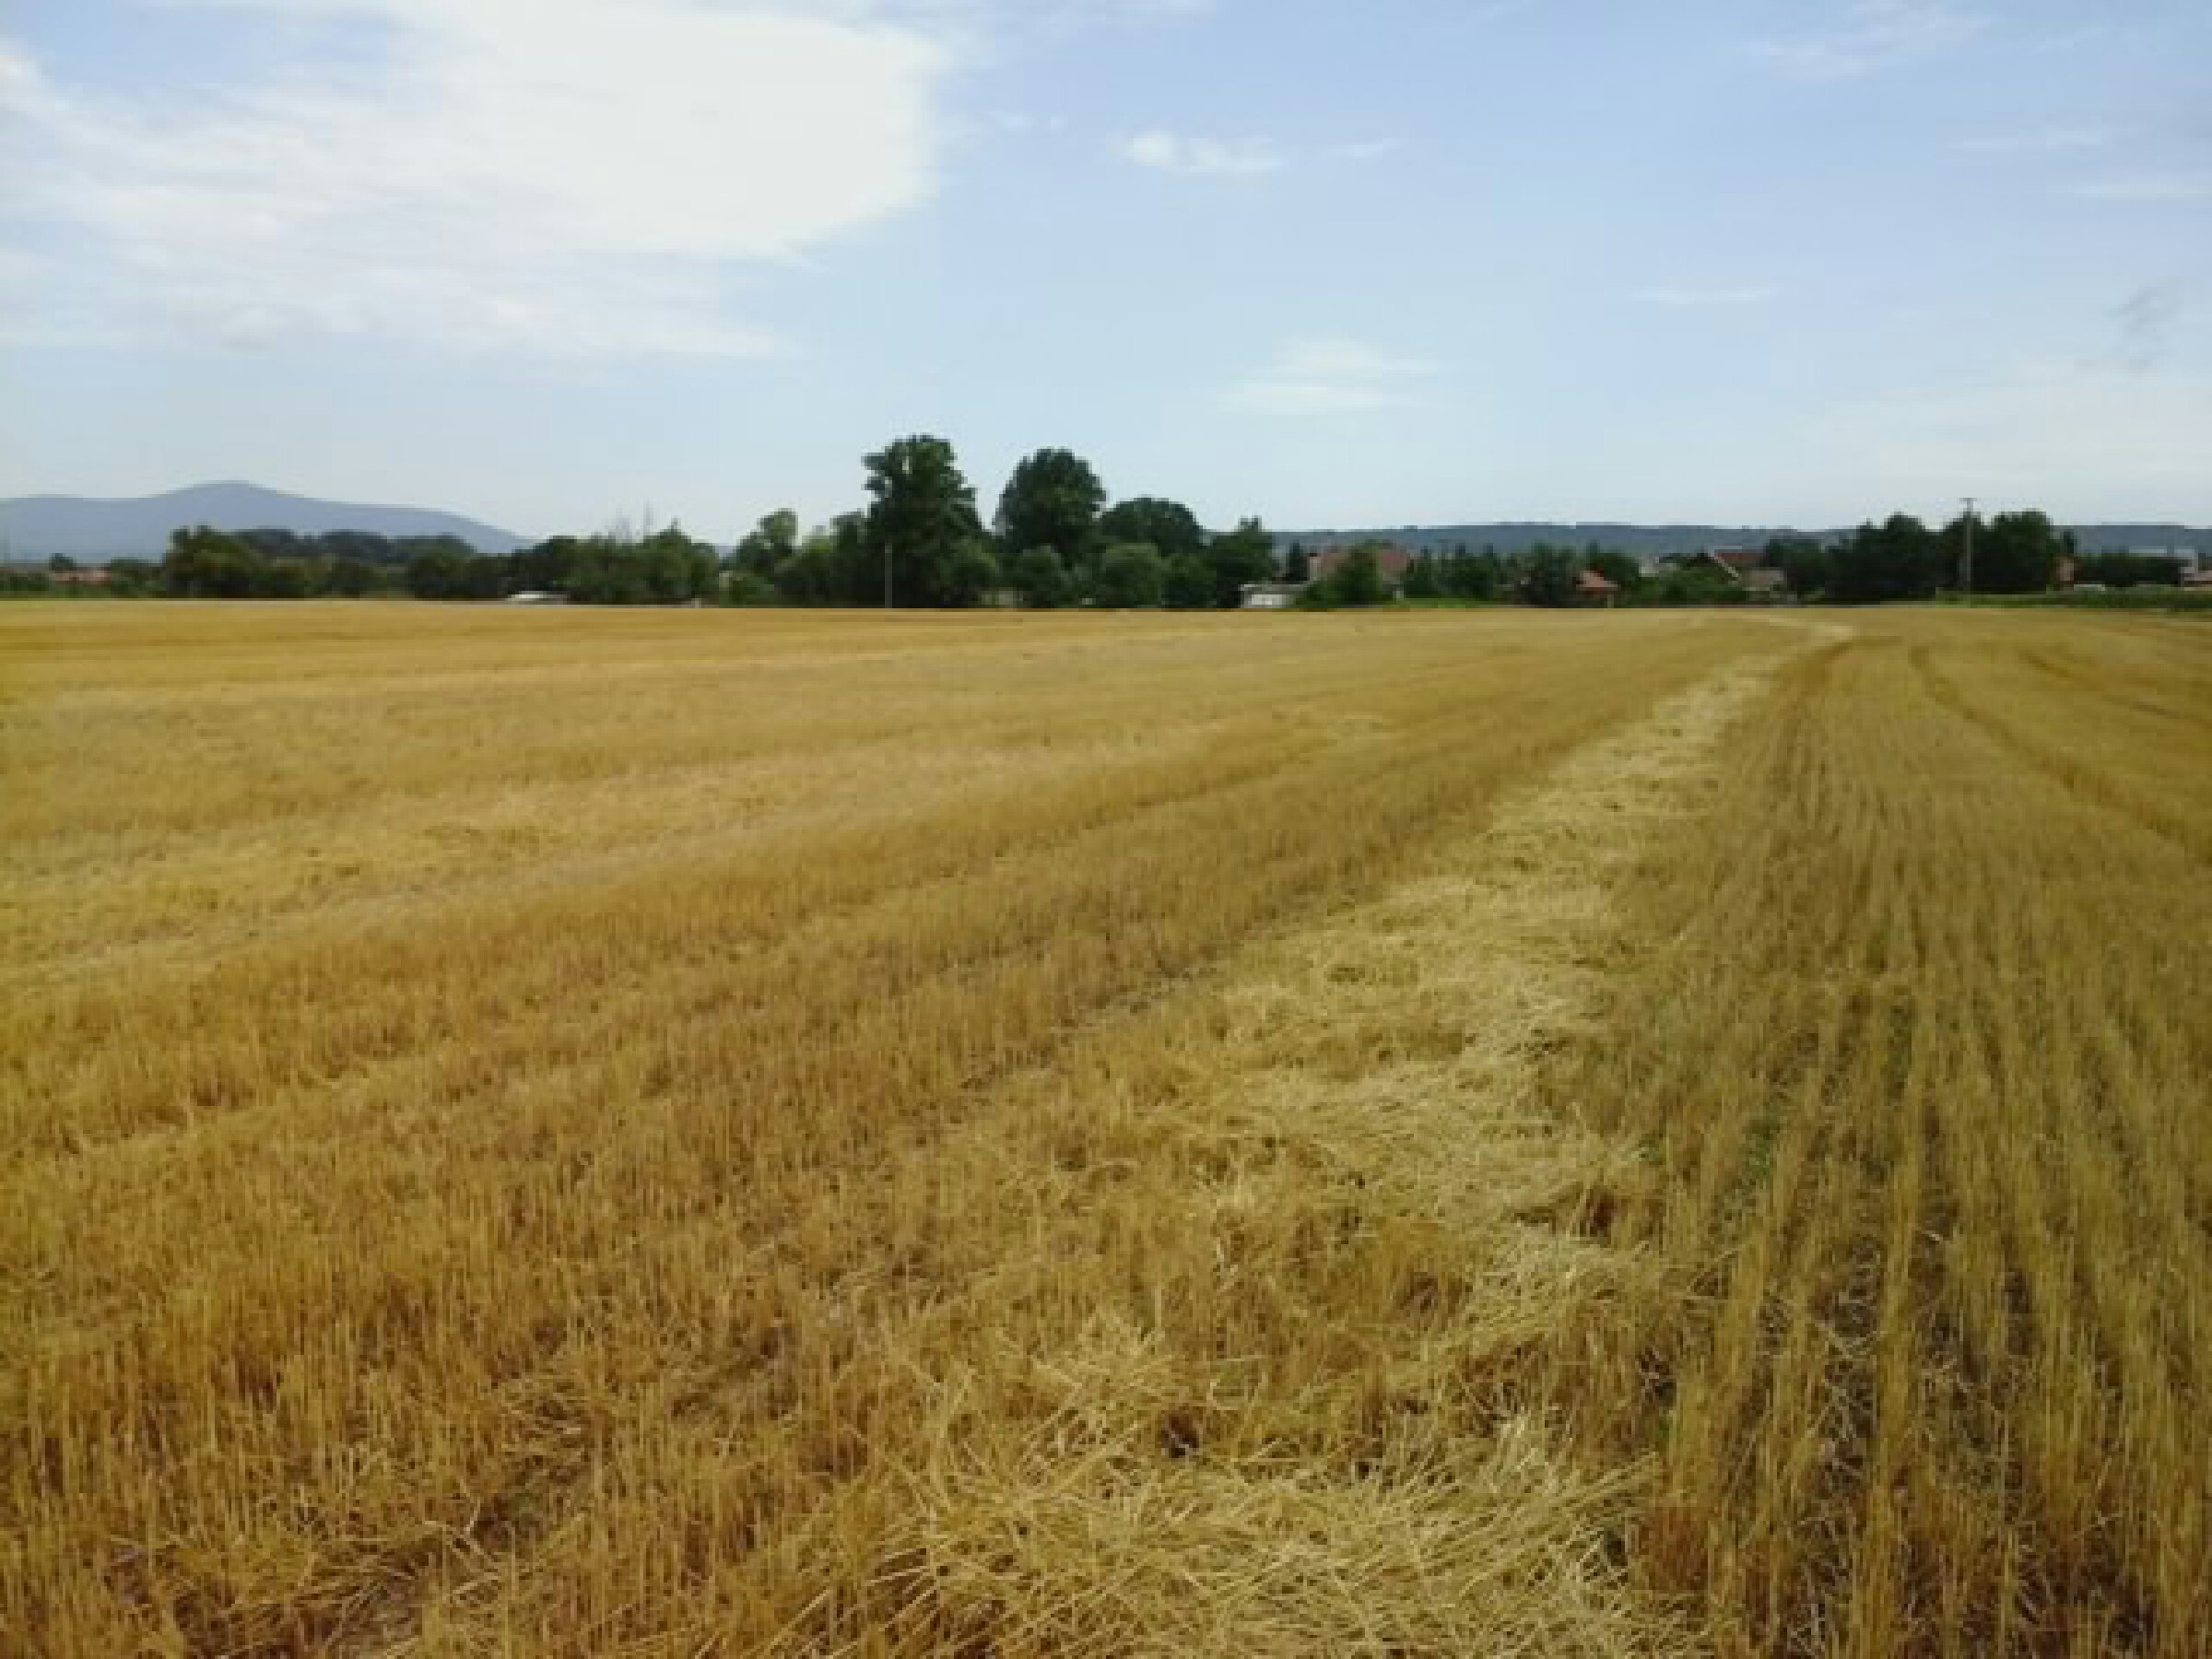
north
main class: Cropland
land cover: Common wheat
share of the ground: > 75 %
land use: Agriculture (excluding fallow land and kitchen gardens)
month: July
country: HU
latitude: 47.7133
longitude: 19.1767
